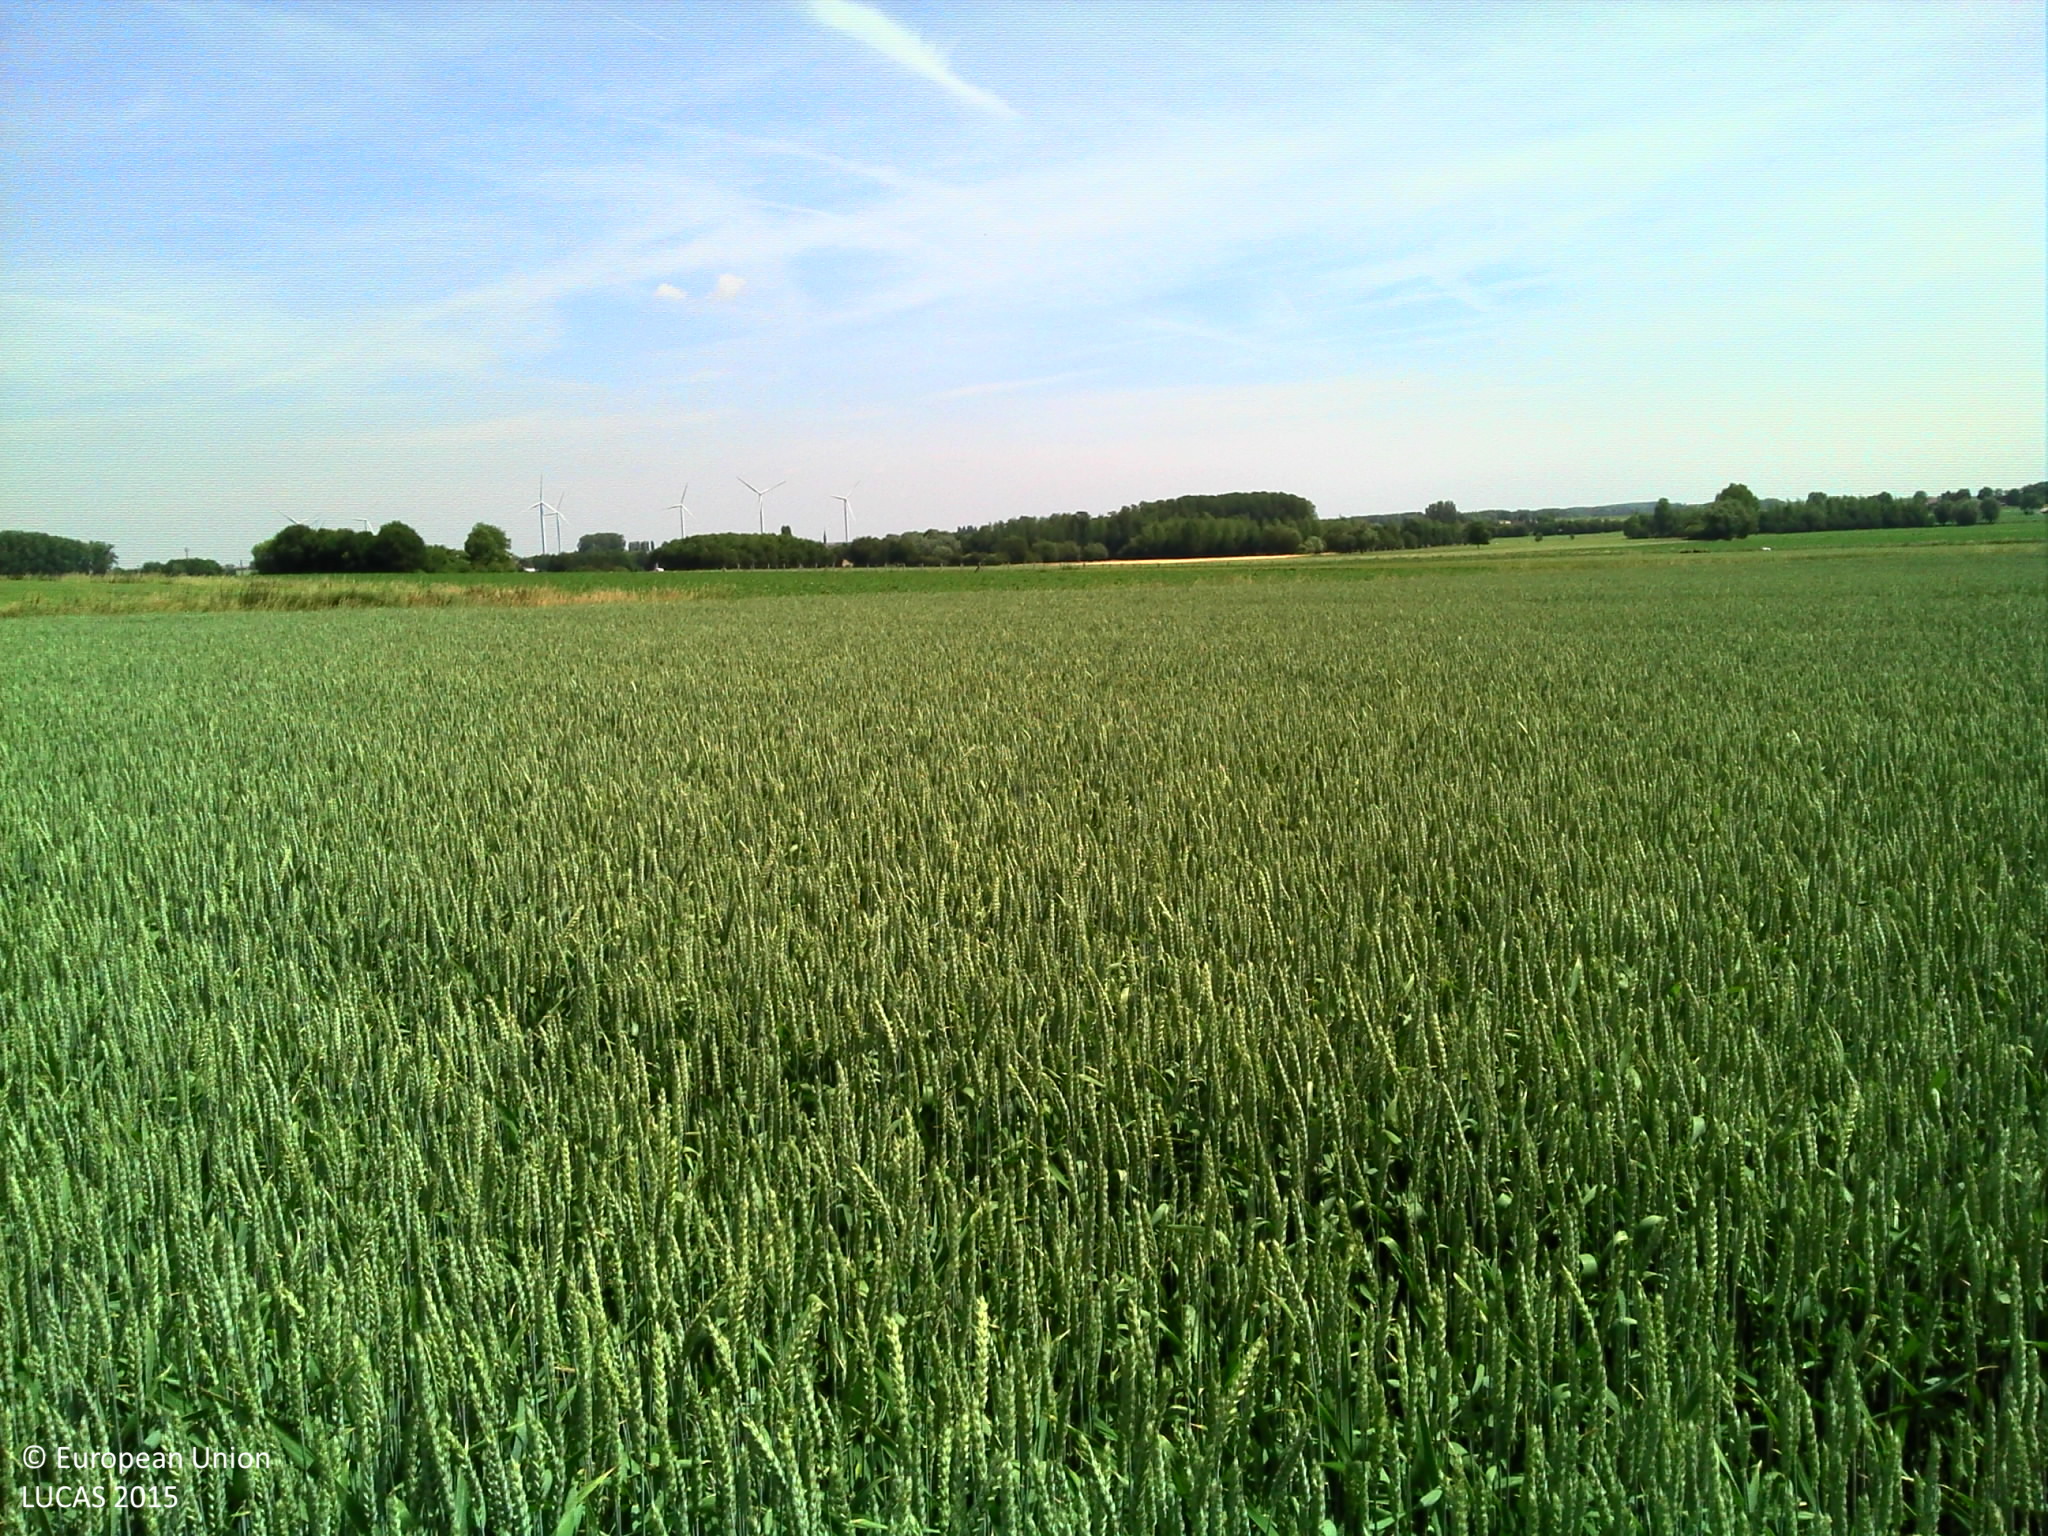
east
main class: Cropland
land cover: Common wheat
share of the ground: > 75 %
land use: Agriculture (excluding fallow land and kitchen gardens)
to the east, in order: Common wheat; Tracks; Ditches and canals; Potatoes; Common wheat; Grass margins; Fences; Grassland without tree/shrub cover
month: June
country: BE
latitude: 50.5814
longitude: 3.5951
